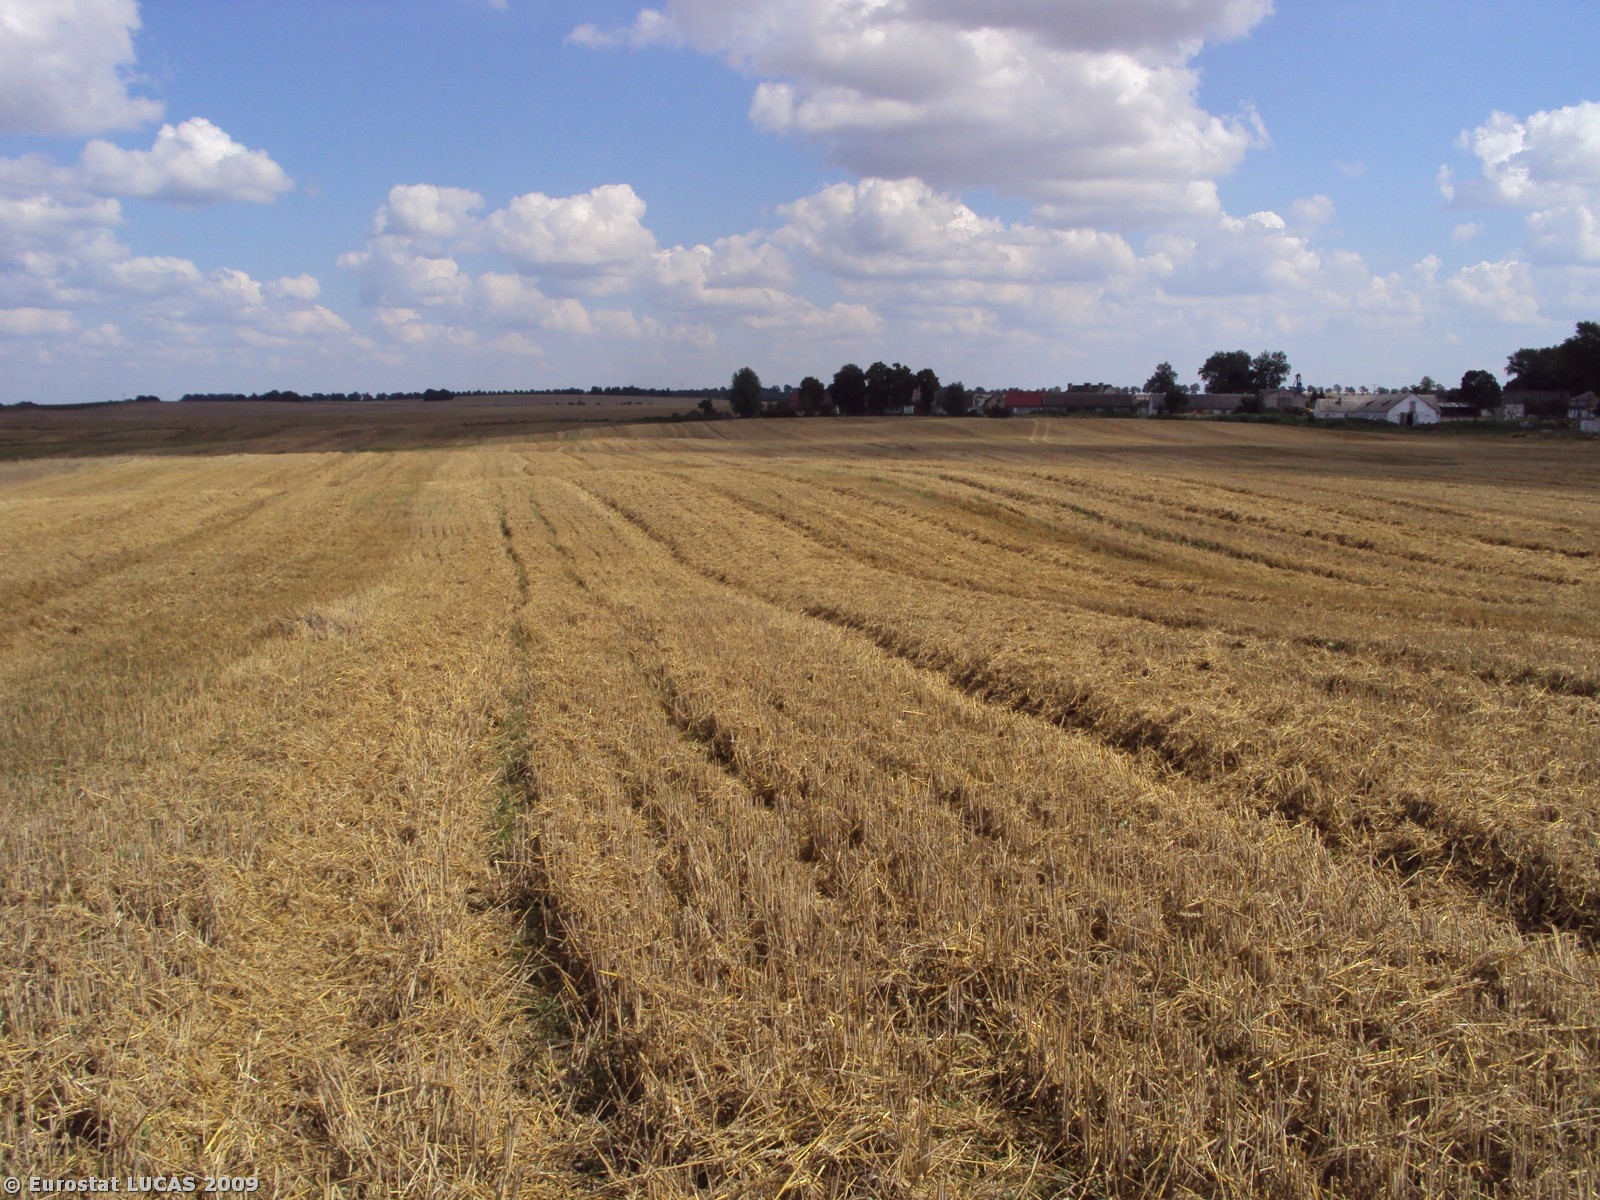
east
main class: Cropland
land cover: Common wheat
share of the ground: < 10 %
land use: Agriculture (excluding fallow land and kitchen gardens)
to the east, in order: Common wheat
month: August
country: PL
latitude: 53.2146
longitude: 16.4010
